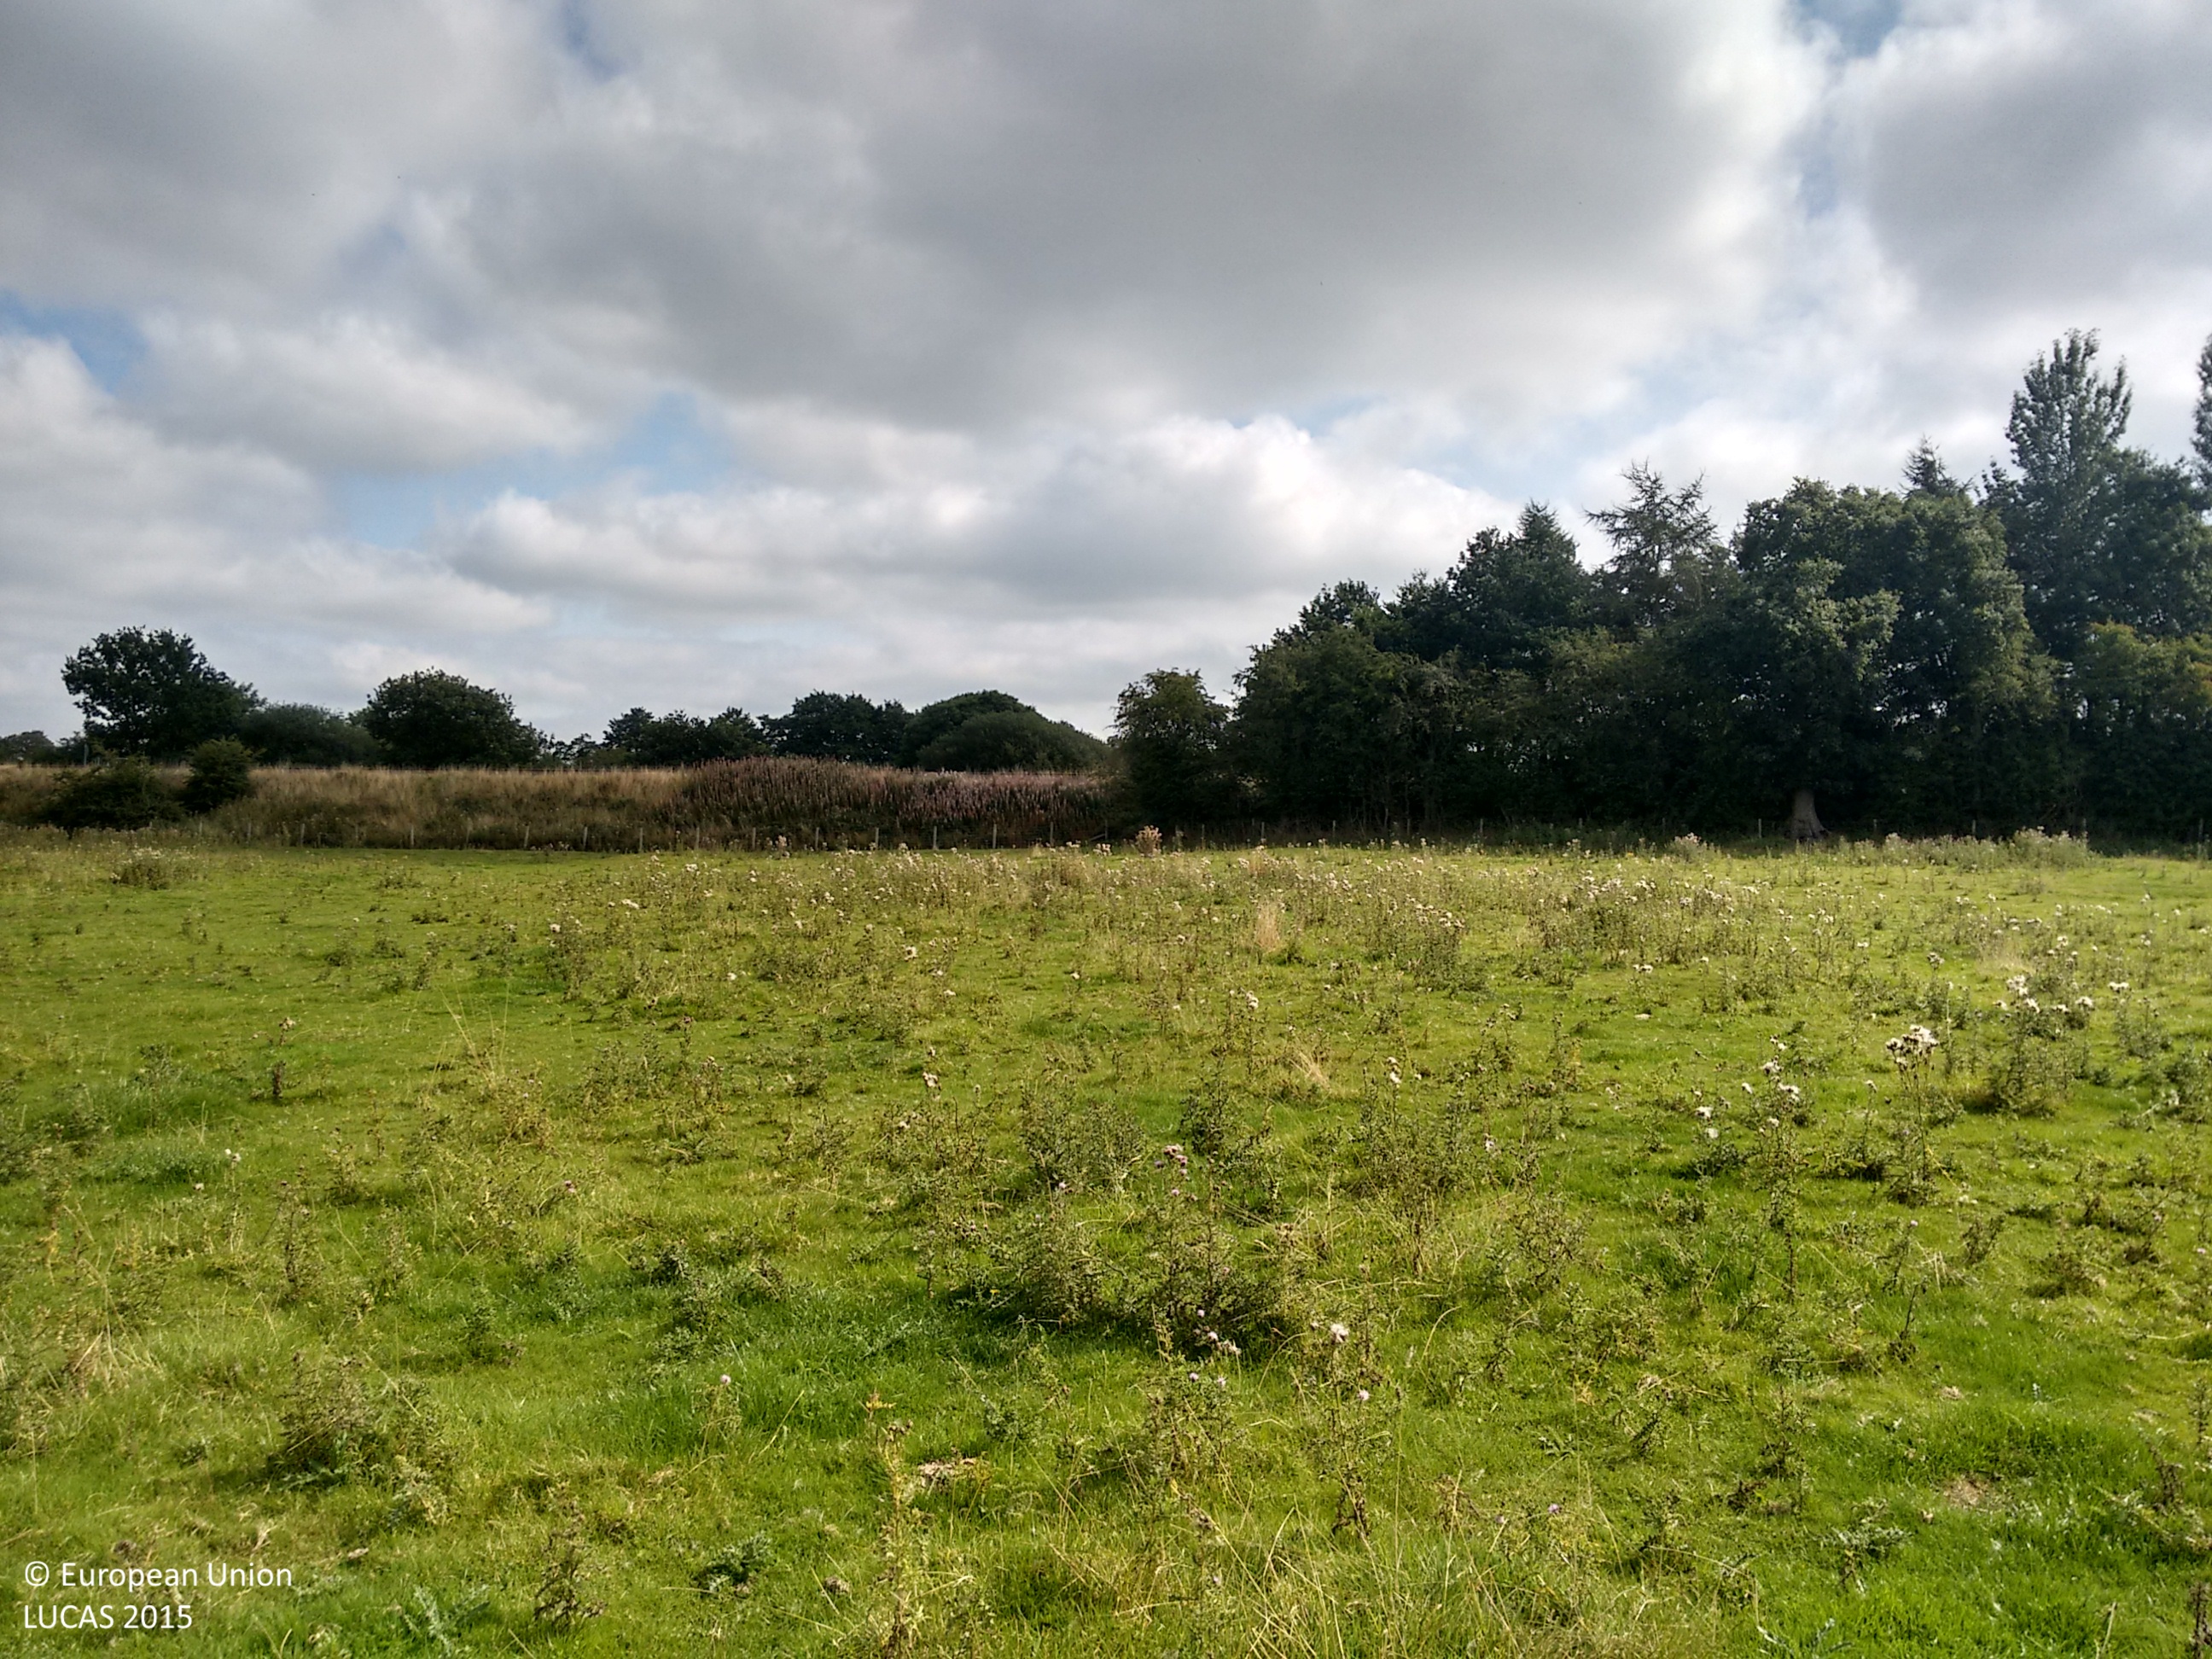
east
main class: Grassland
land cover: Grassland without tree/shrub cover
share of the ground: > 75 %
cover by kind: herbaceous plants 100 %
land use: Agriculture (excluding fallow land and kitchen gardens)
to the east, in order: Grassland without tree/shrub cover; Fences; Broadleaved woodland; Fences; Grass margins; Railways; Grass margins; Fences; Grassland without tree/shrub cover; Grassland with sparse tree/shrub cover; Abandoned hedges; Ponds and wetlands; Grass margins; Fences; Grassland without tree/shrub cover
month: September
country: GB
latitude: 52.9333
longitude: -2.6703
